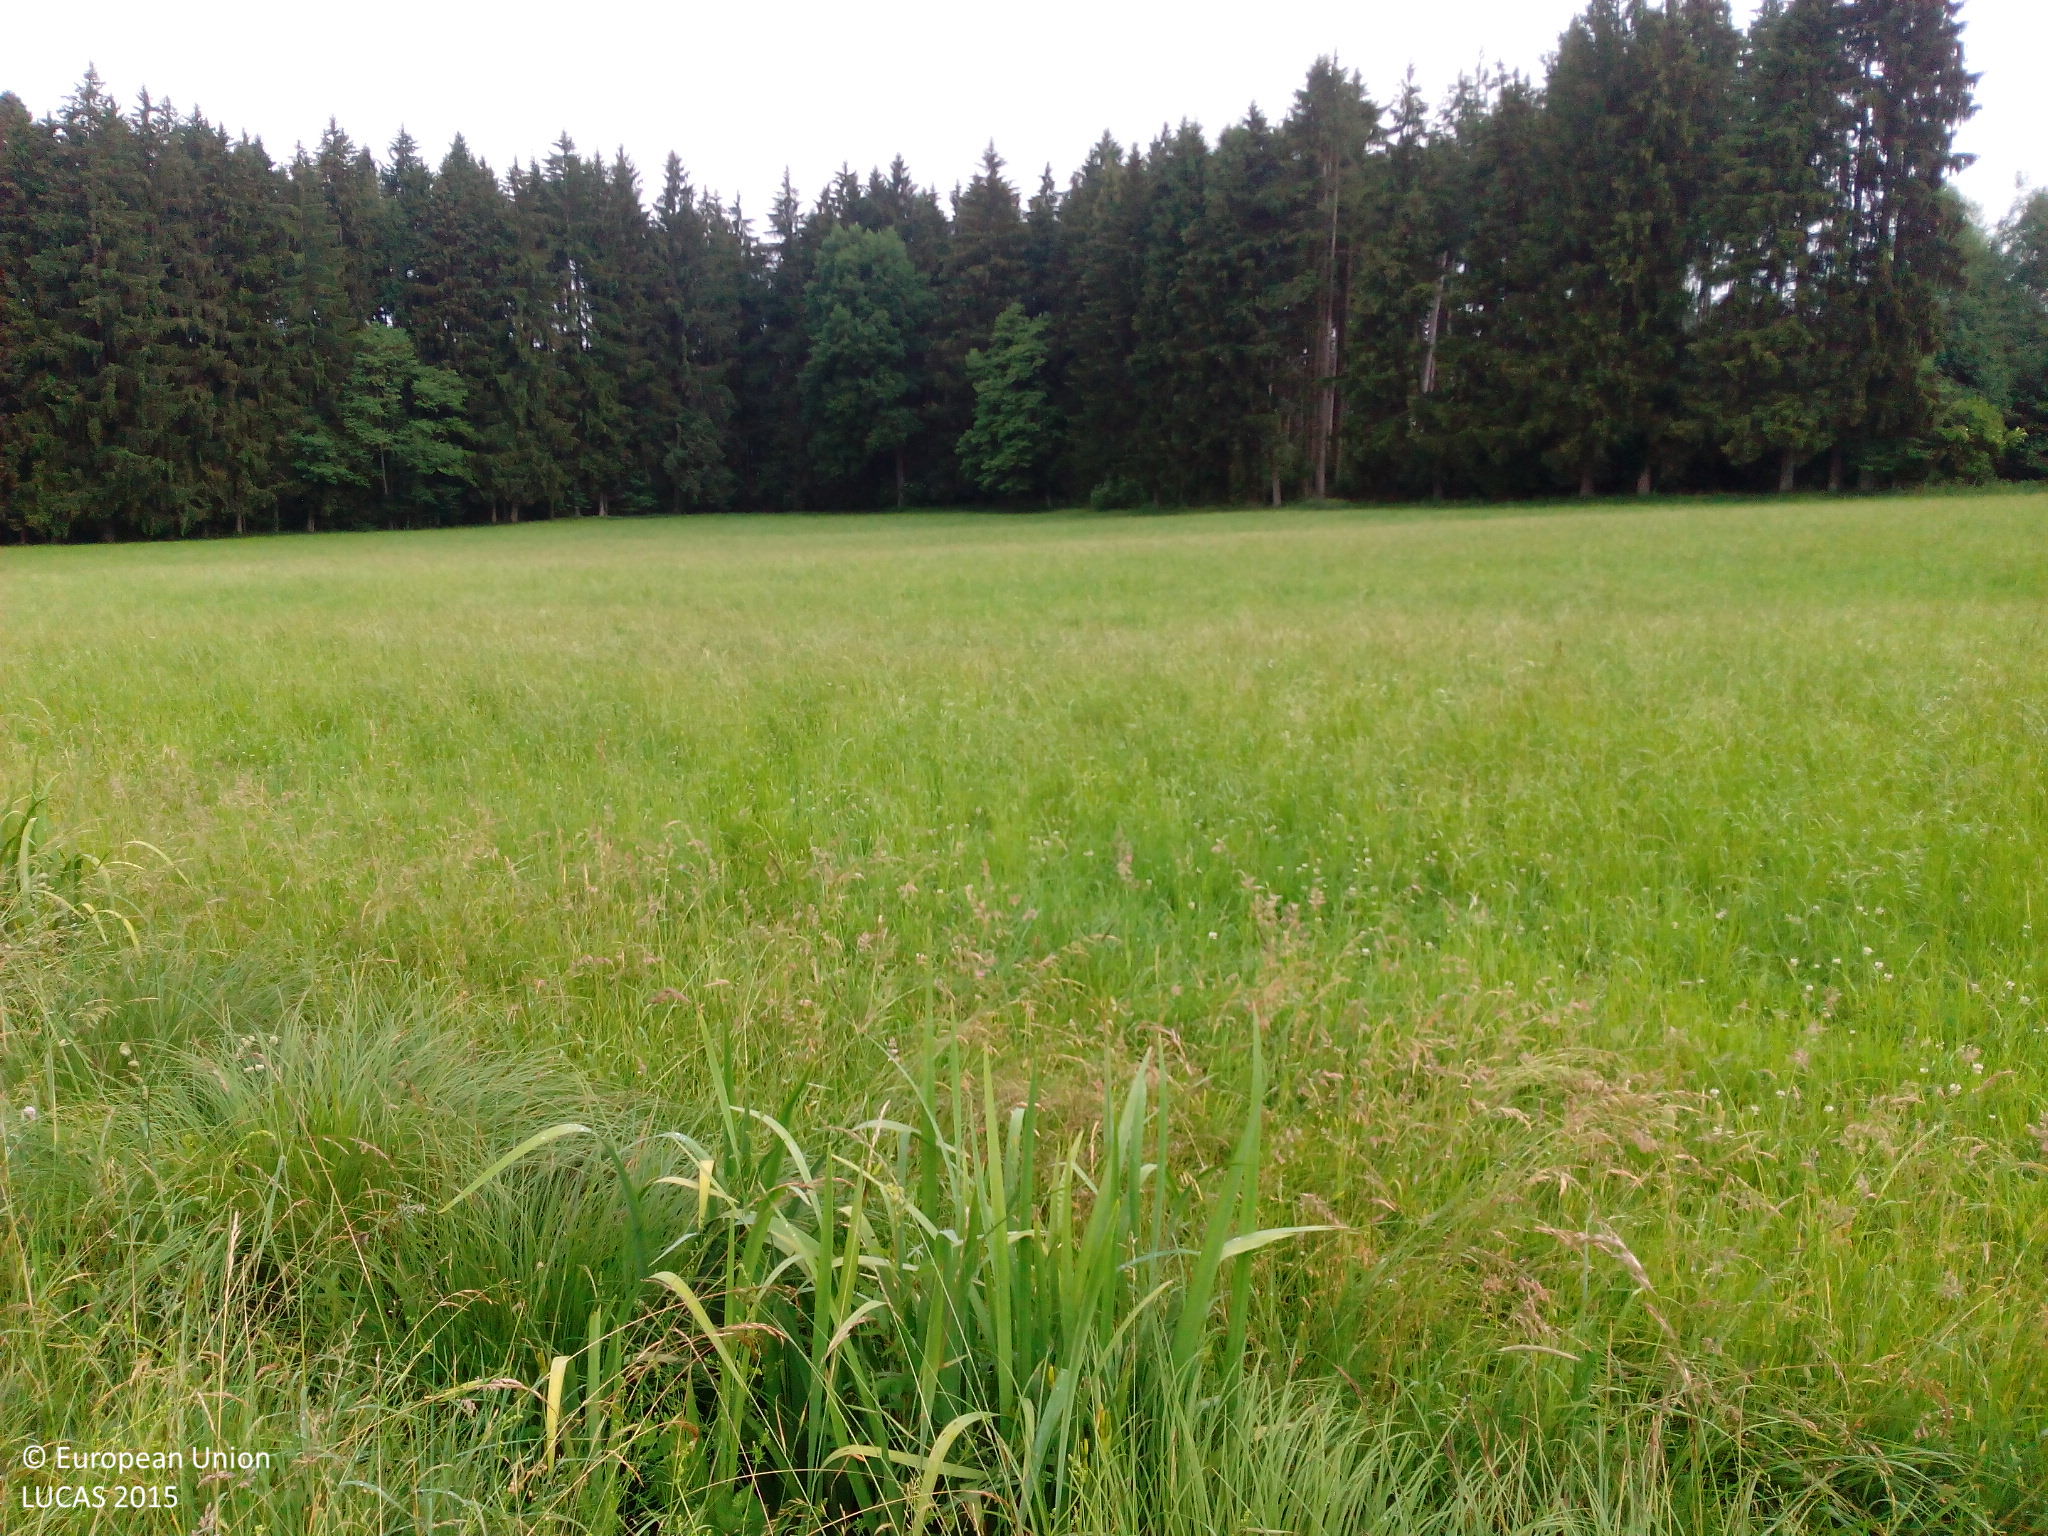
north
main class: Grassland
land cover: Grassland without tree/shrub cover
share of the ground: > 75 %
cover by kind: herbaceous plants 100 %
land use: Agriculture (excluding fallow land and kitchen gardens)
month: June
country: DE
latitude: 47.6296
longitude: 9.9335
